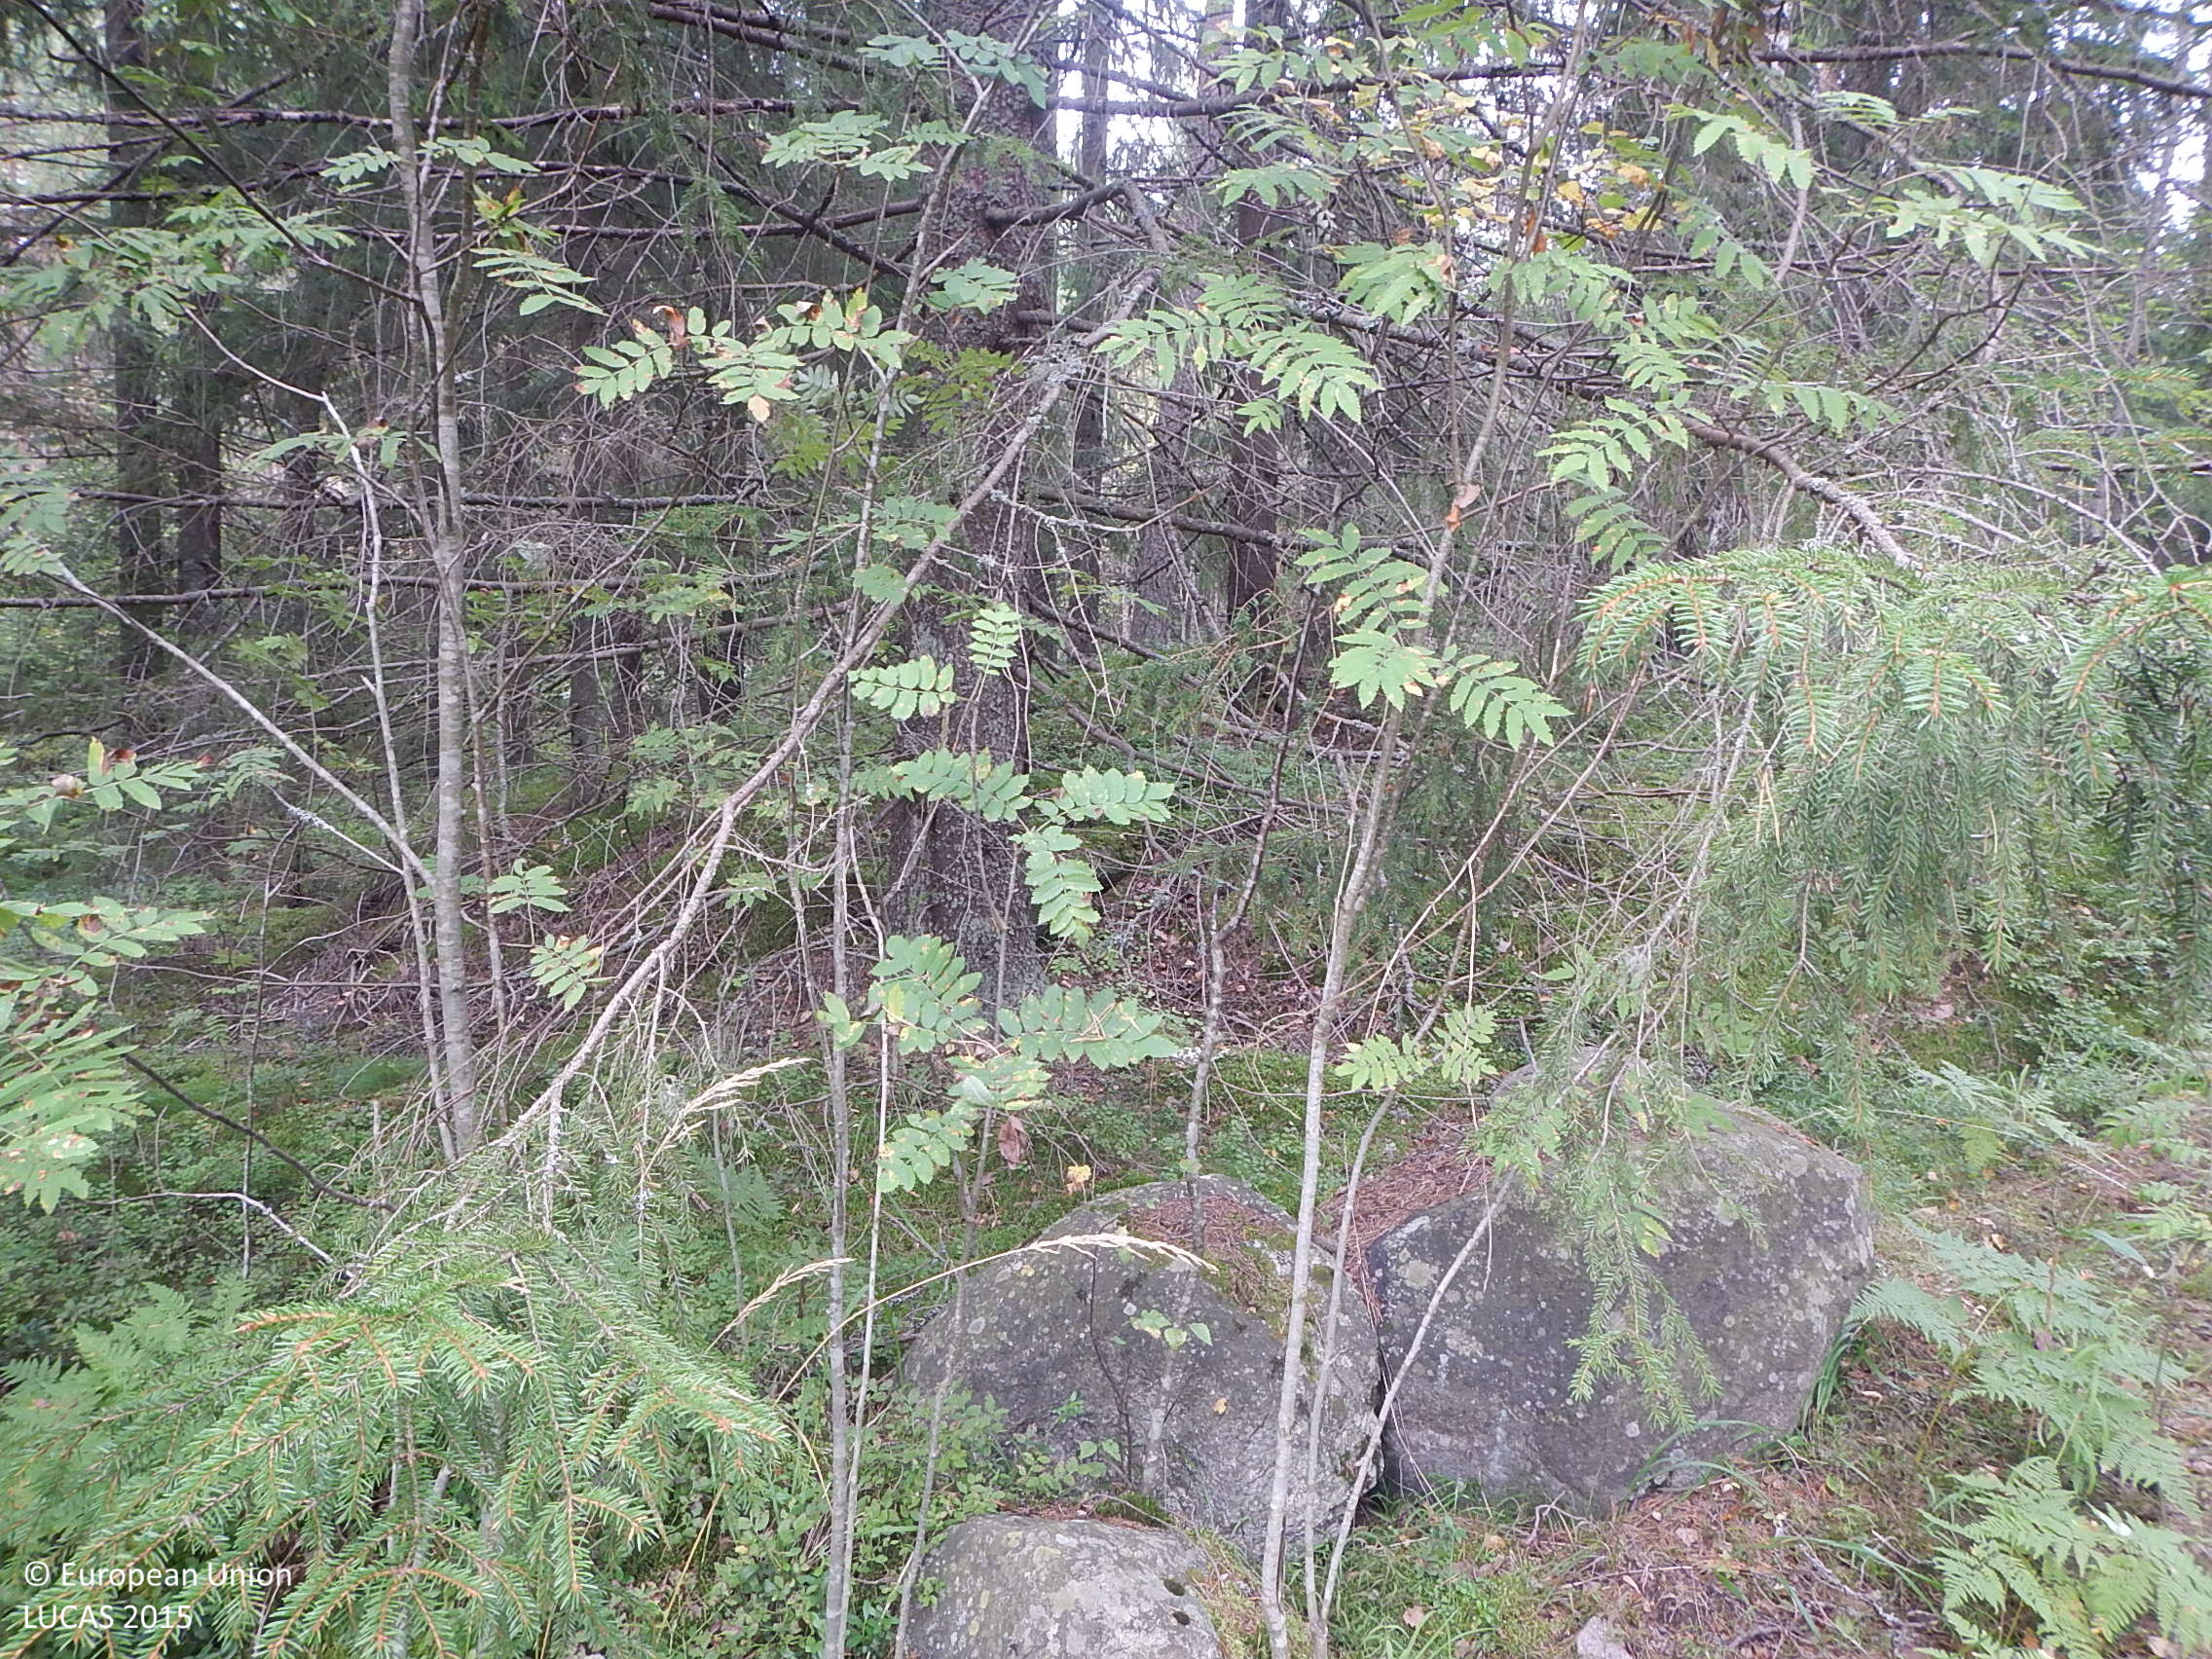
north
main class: Woodland
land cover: Other coniferous woodland
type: boreal forest
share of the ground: > 75 %
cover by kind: coniferous forest trees 75 %, shrubs 10 %, herbaceous plants 10 %, lichens and mosses 5 %
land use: Forestry
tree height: > 5 m
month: September
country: FI
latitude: 61.4809
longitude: 22.9692
